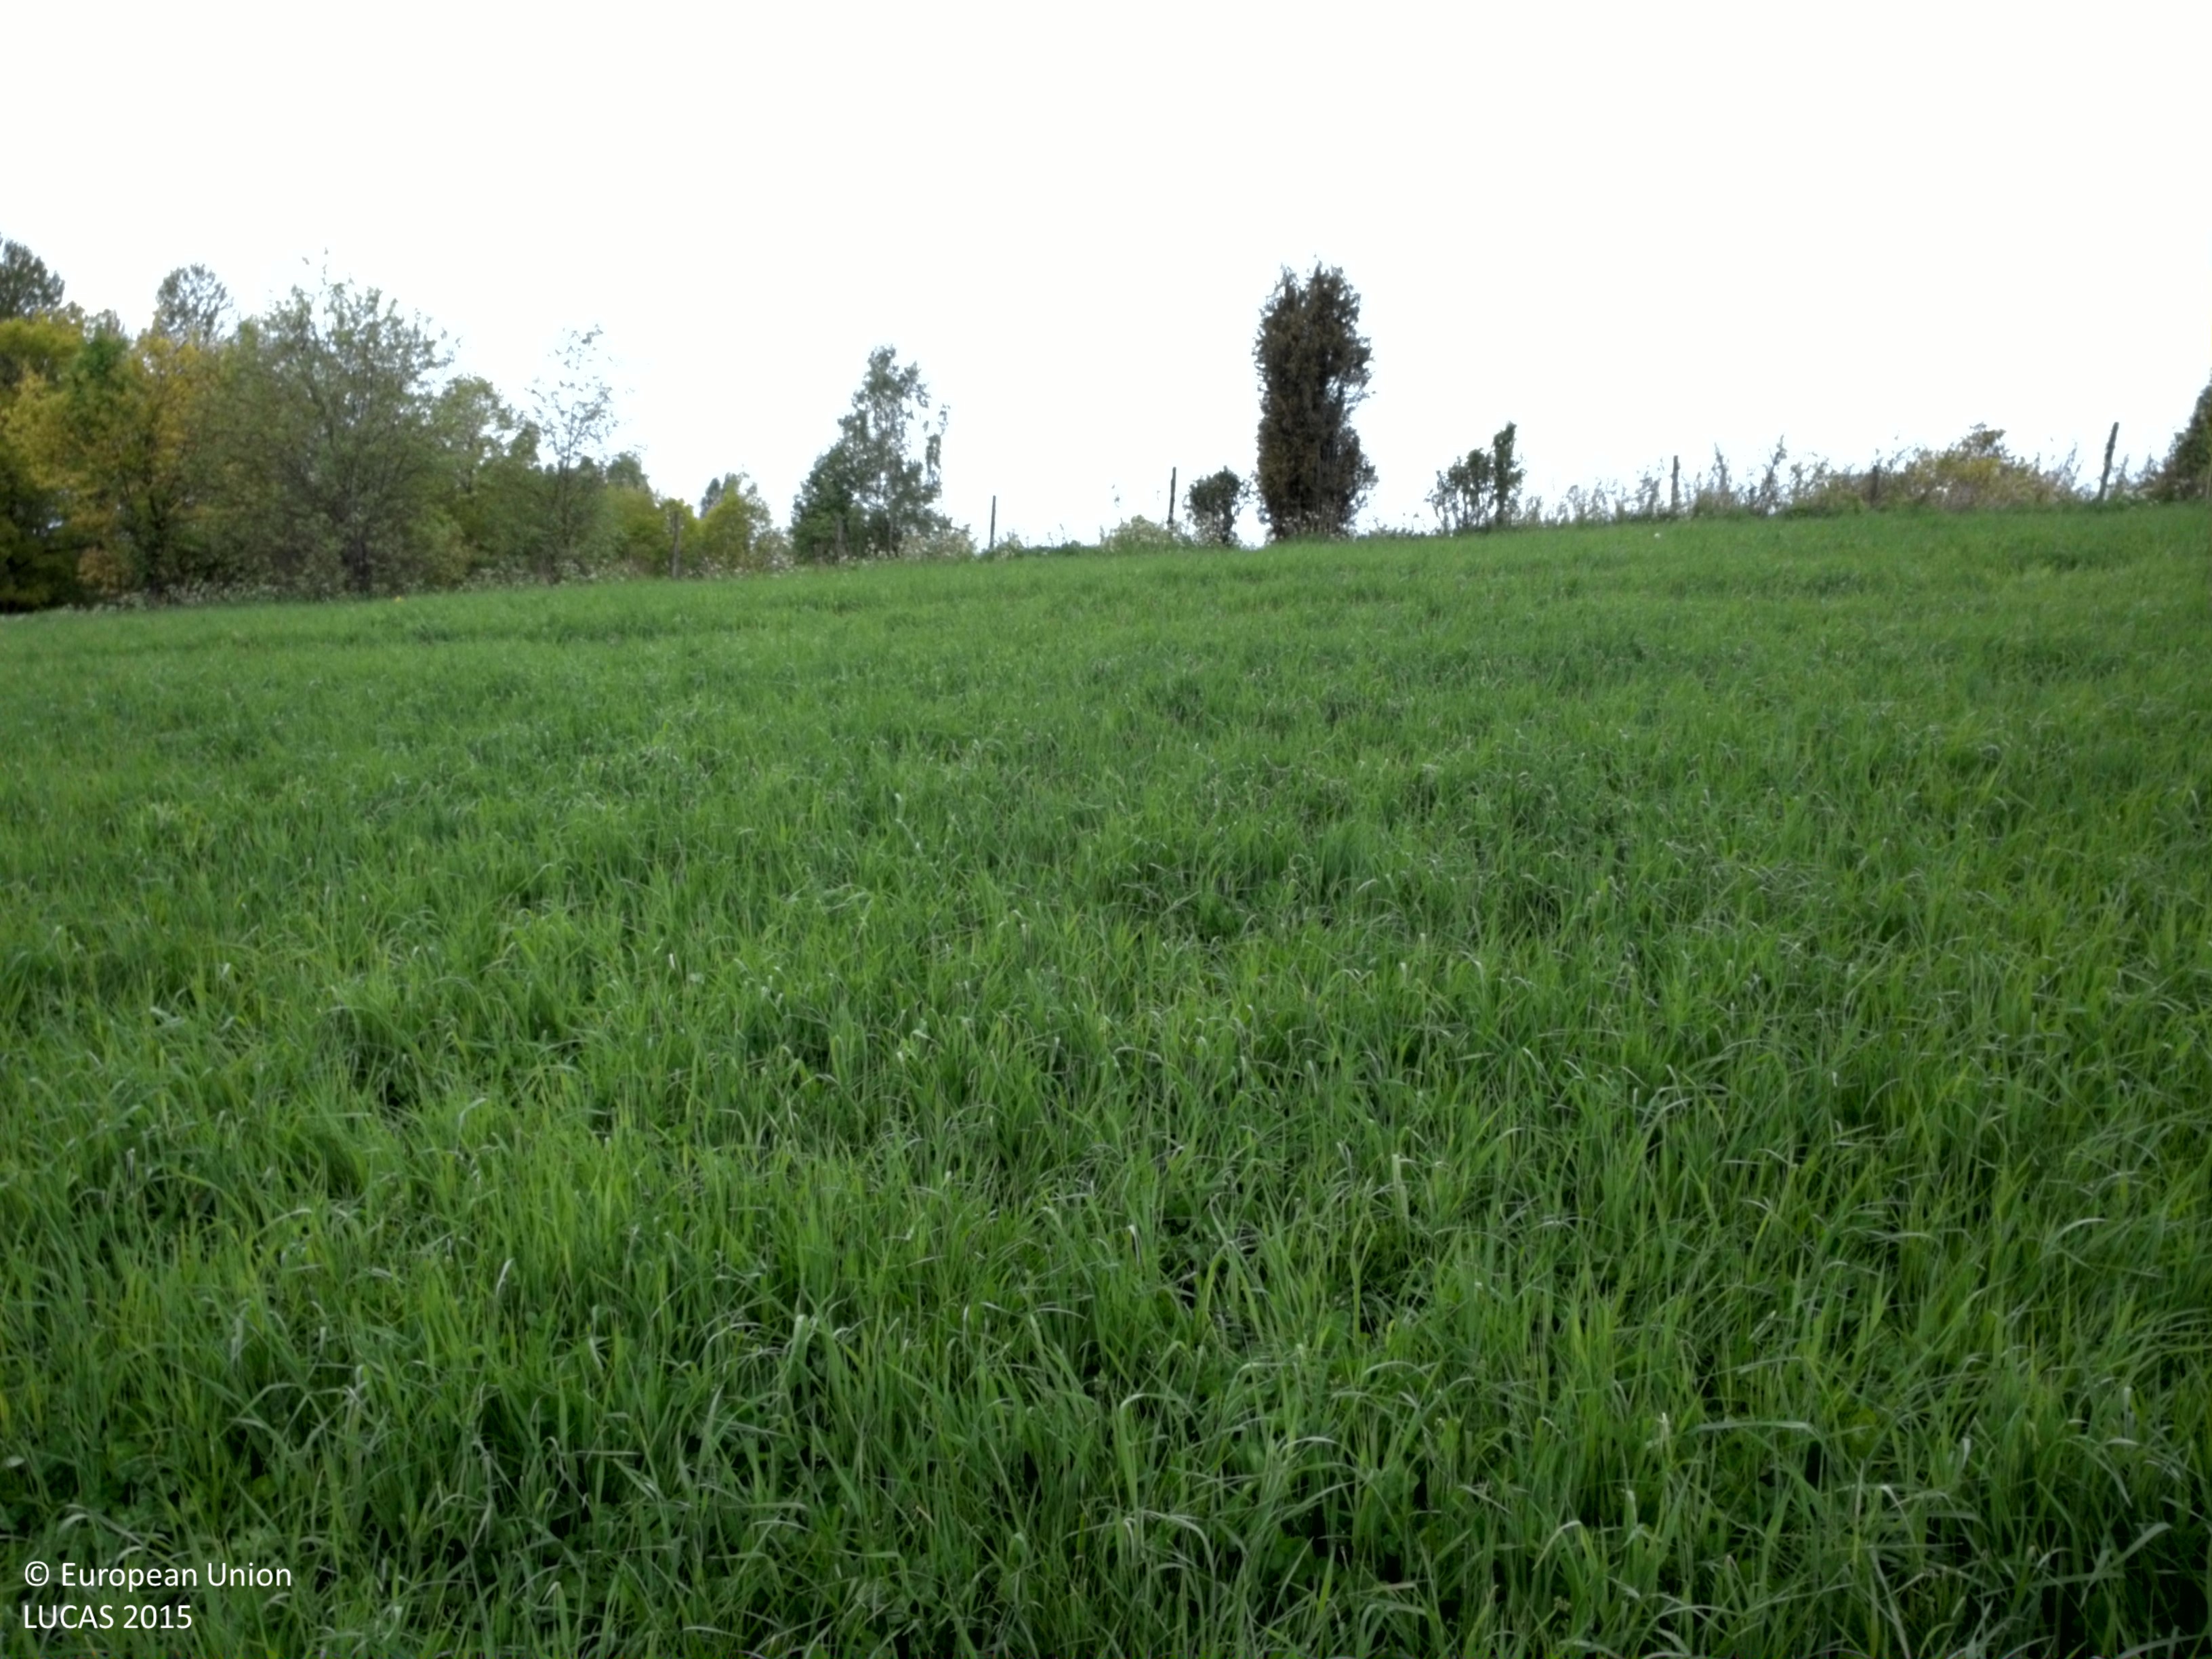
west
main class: Cropland
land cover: Mixed cereals for fodder
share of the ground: > 75 %
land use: Agriculture (excluding fallow land and kitchen gardens)
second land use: Amenities, museums, leisure
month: May
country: SE
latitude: 57.3843
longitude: 15.5365
